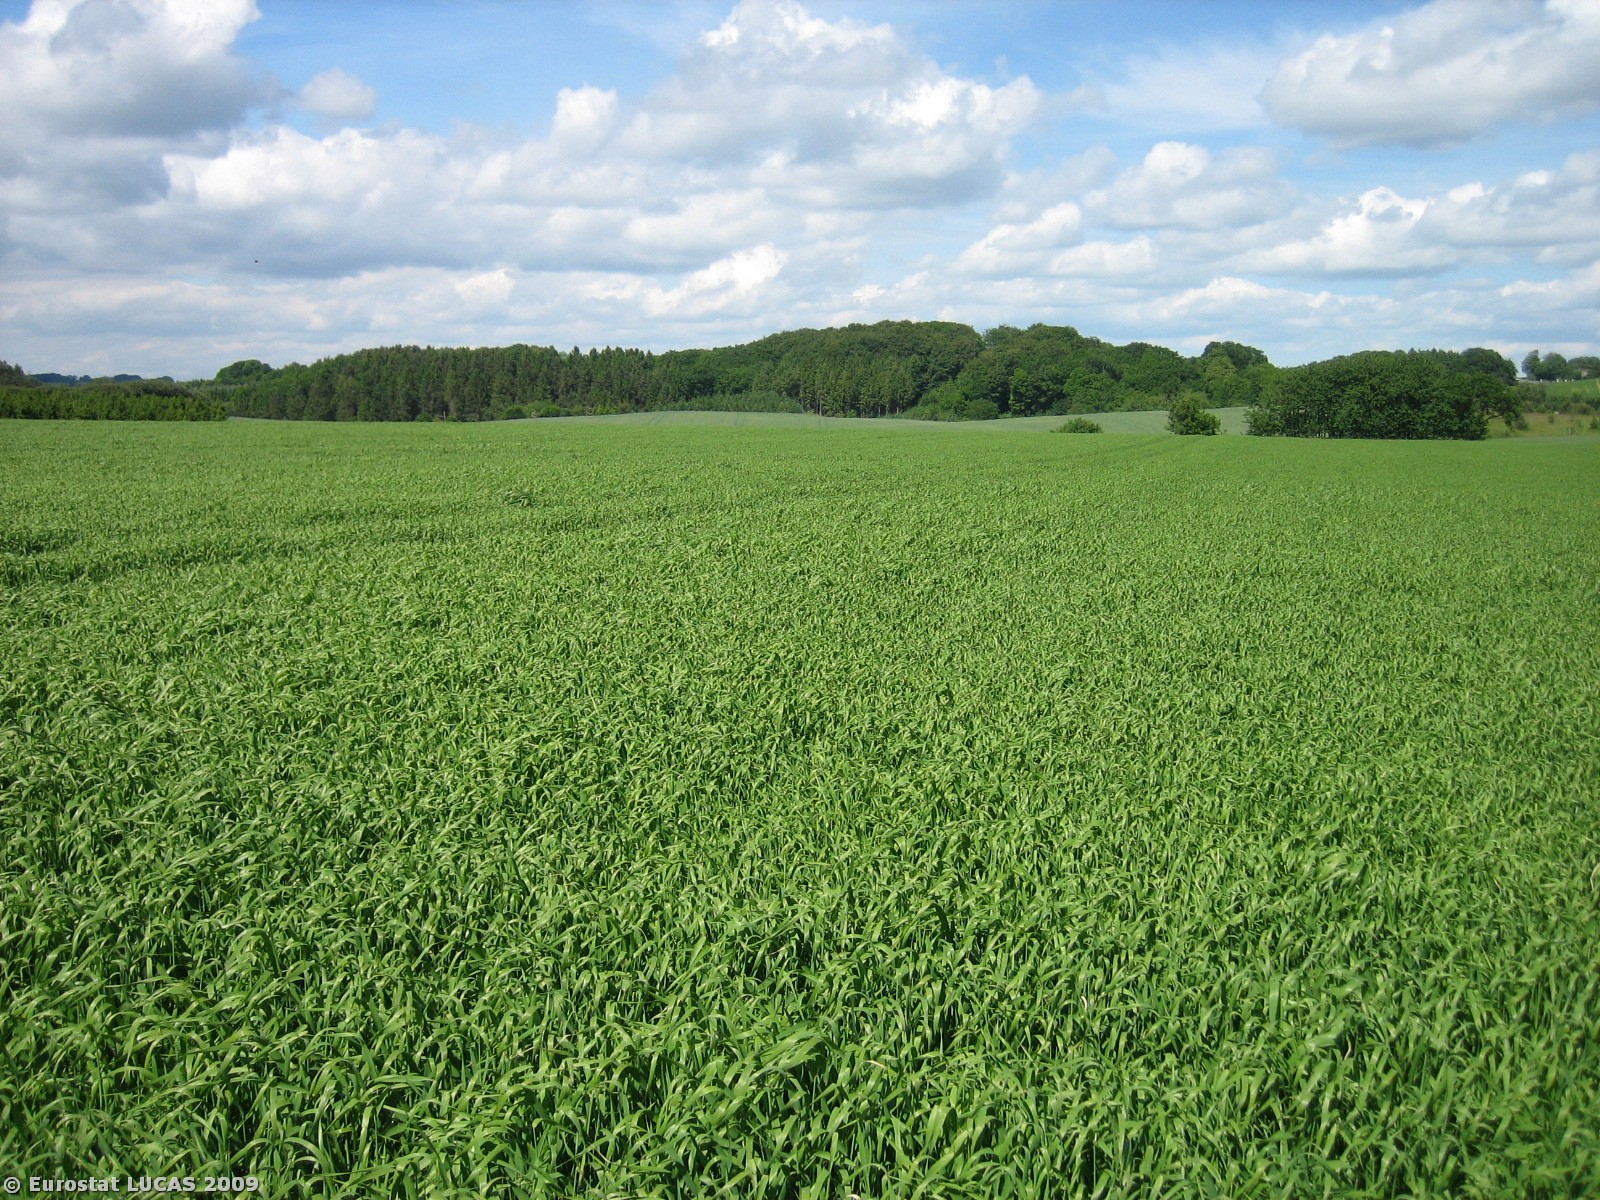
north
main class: Cropland
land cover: Barley
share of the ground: > 75 %
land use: Agriculture (excluding fallow land and kitchen gardens)
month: June
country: DK
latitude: 55.9897
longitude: 9.7278
